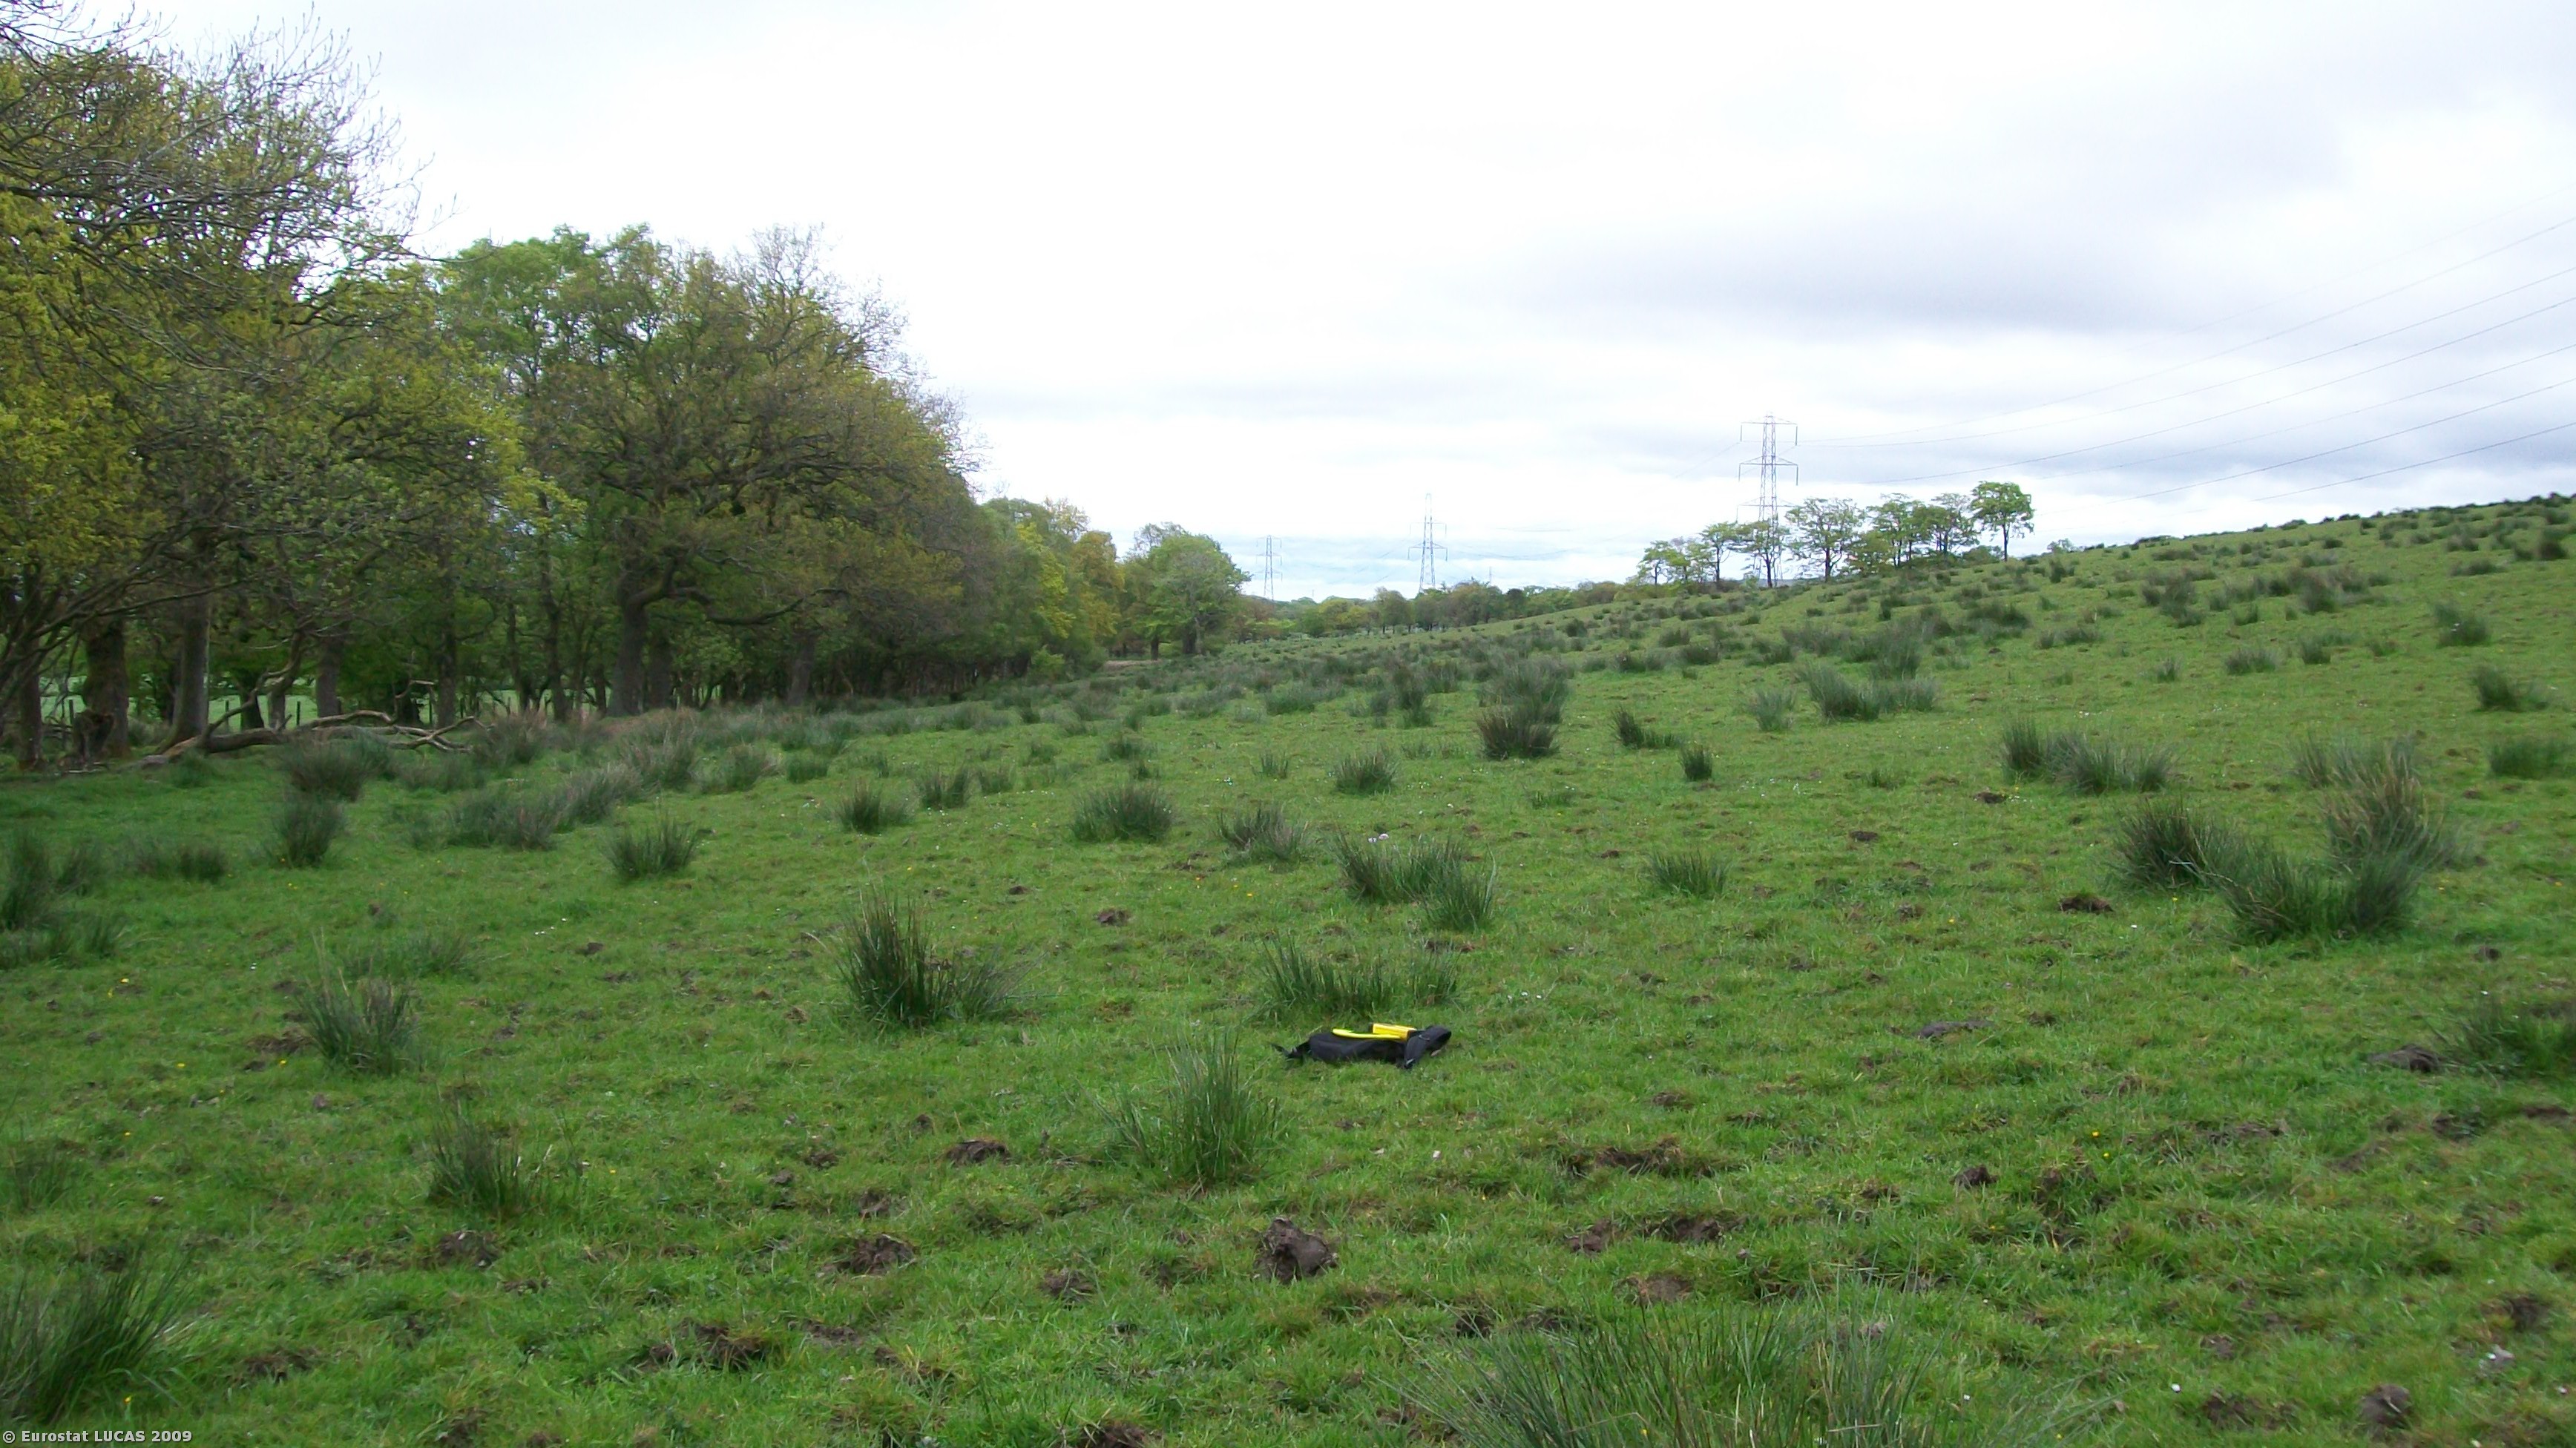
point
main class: Grassland
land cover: Grassland without tree/shrub cover
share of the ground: > 75 %
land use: Agriculture (excluding fallow land and kitchen gardens)
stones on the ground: < 10 %
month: May
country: GB
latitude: 55.8278
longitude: -3.5685
